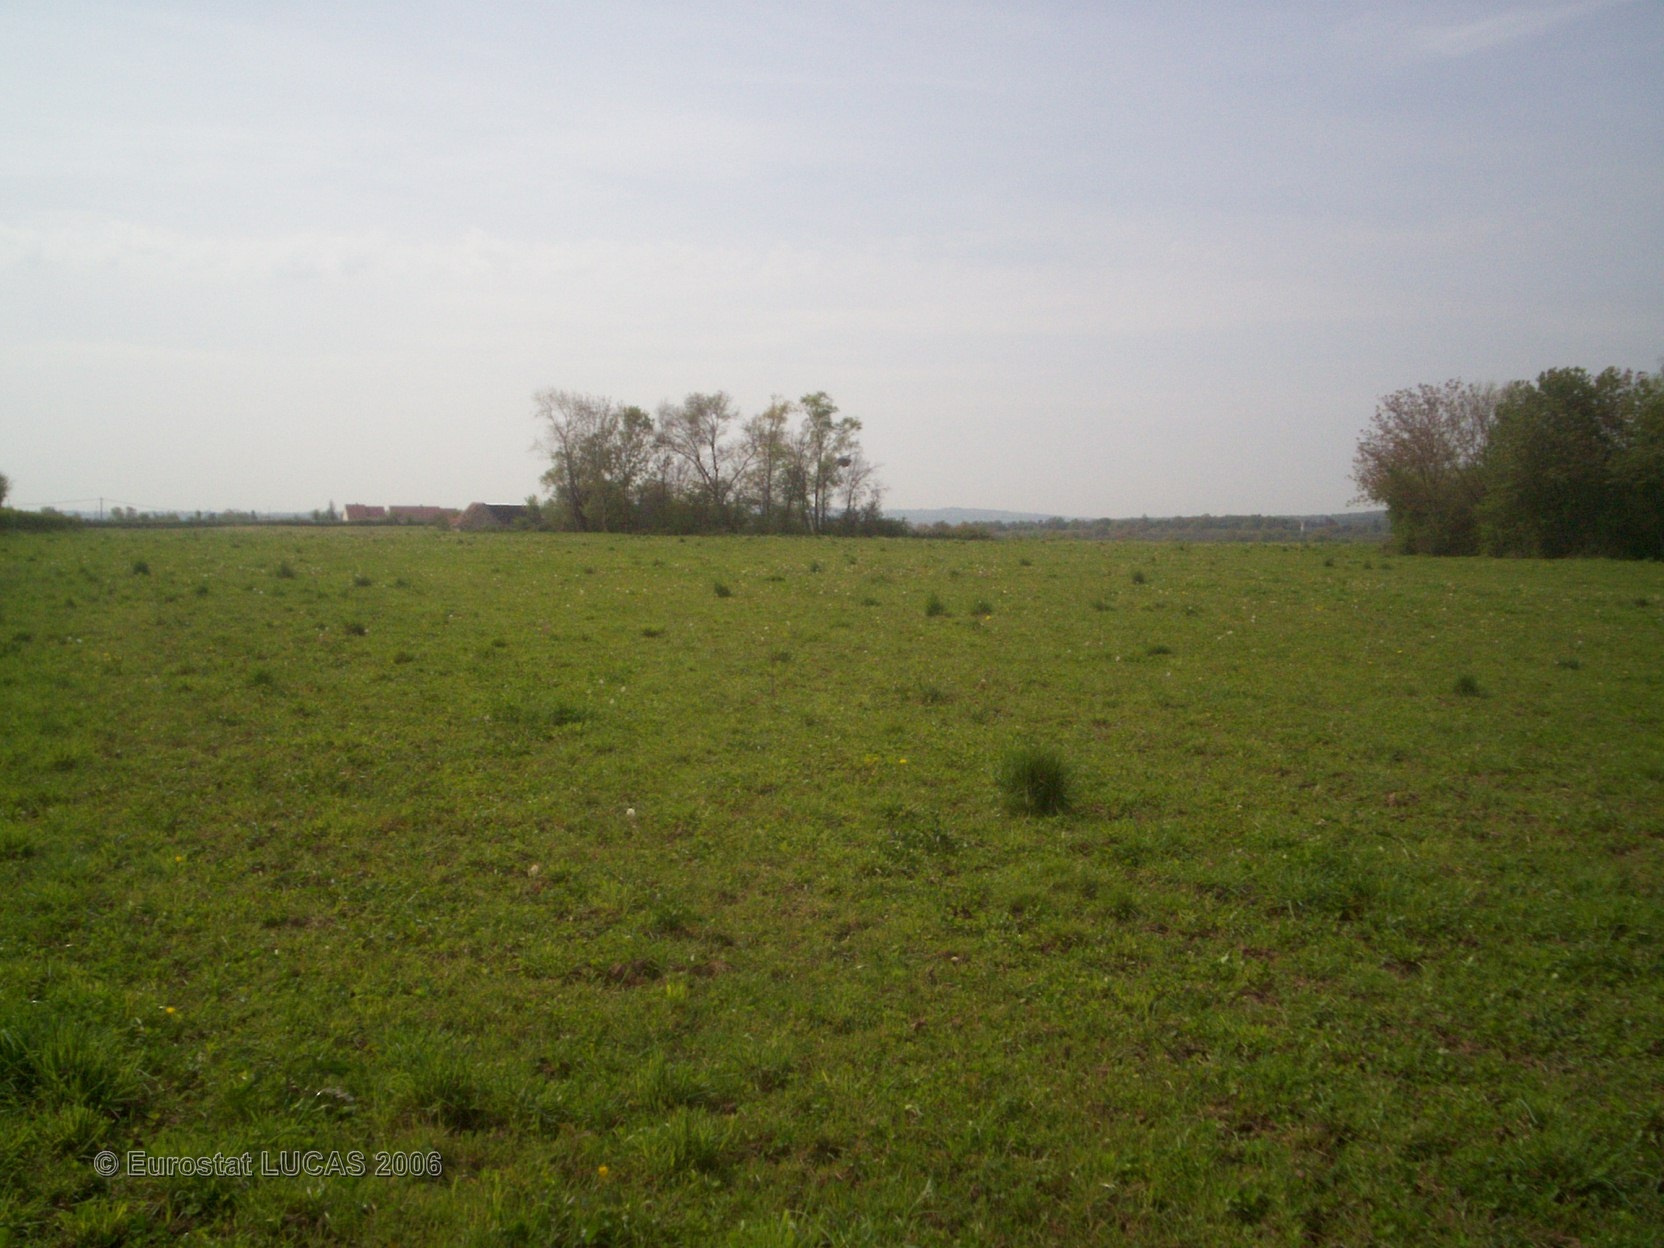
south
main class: Grassland
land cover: Grassland without tree/shrub cover
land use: Agriculture (excluding fallow land and kitchen gardens)
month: May
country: FR
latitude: 46.5472
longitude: 3.1507
